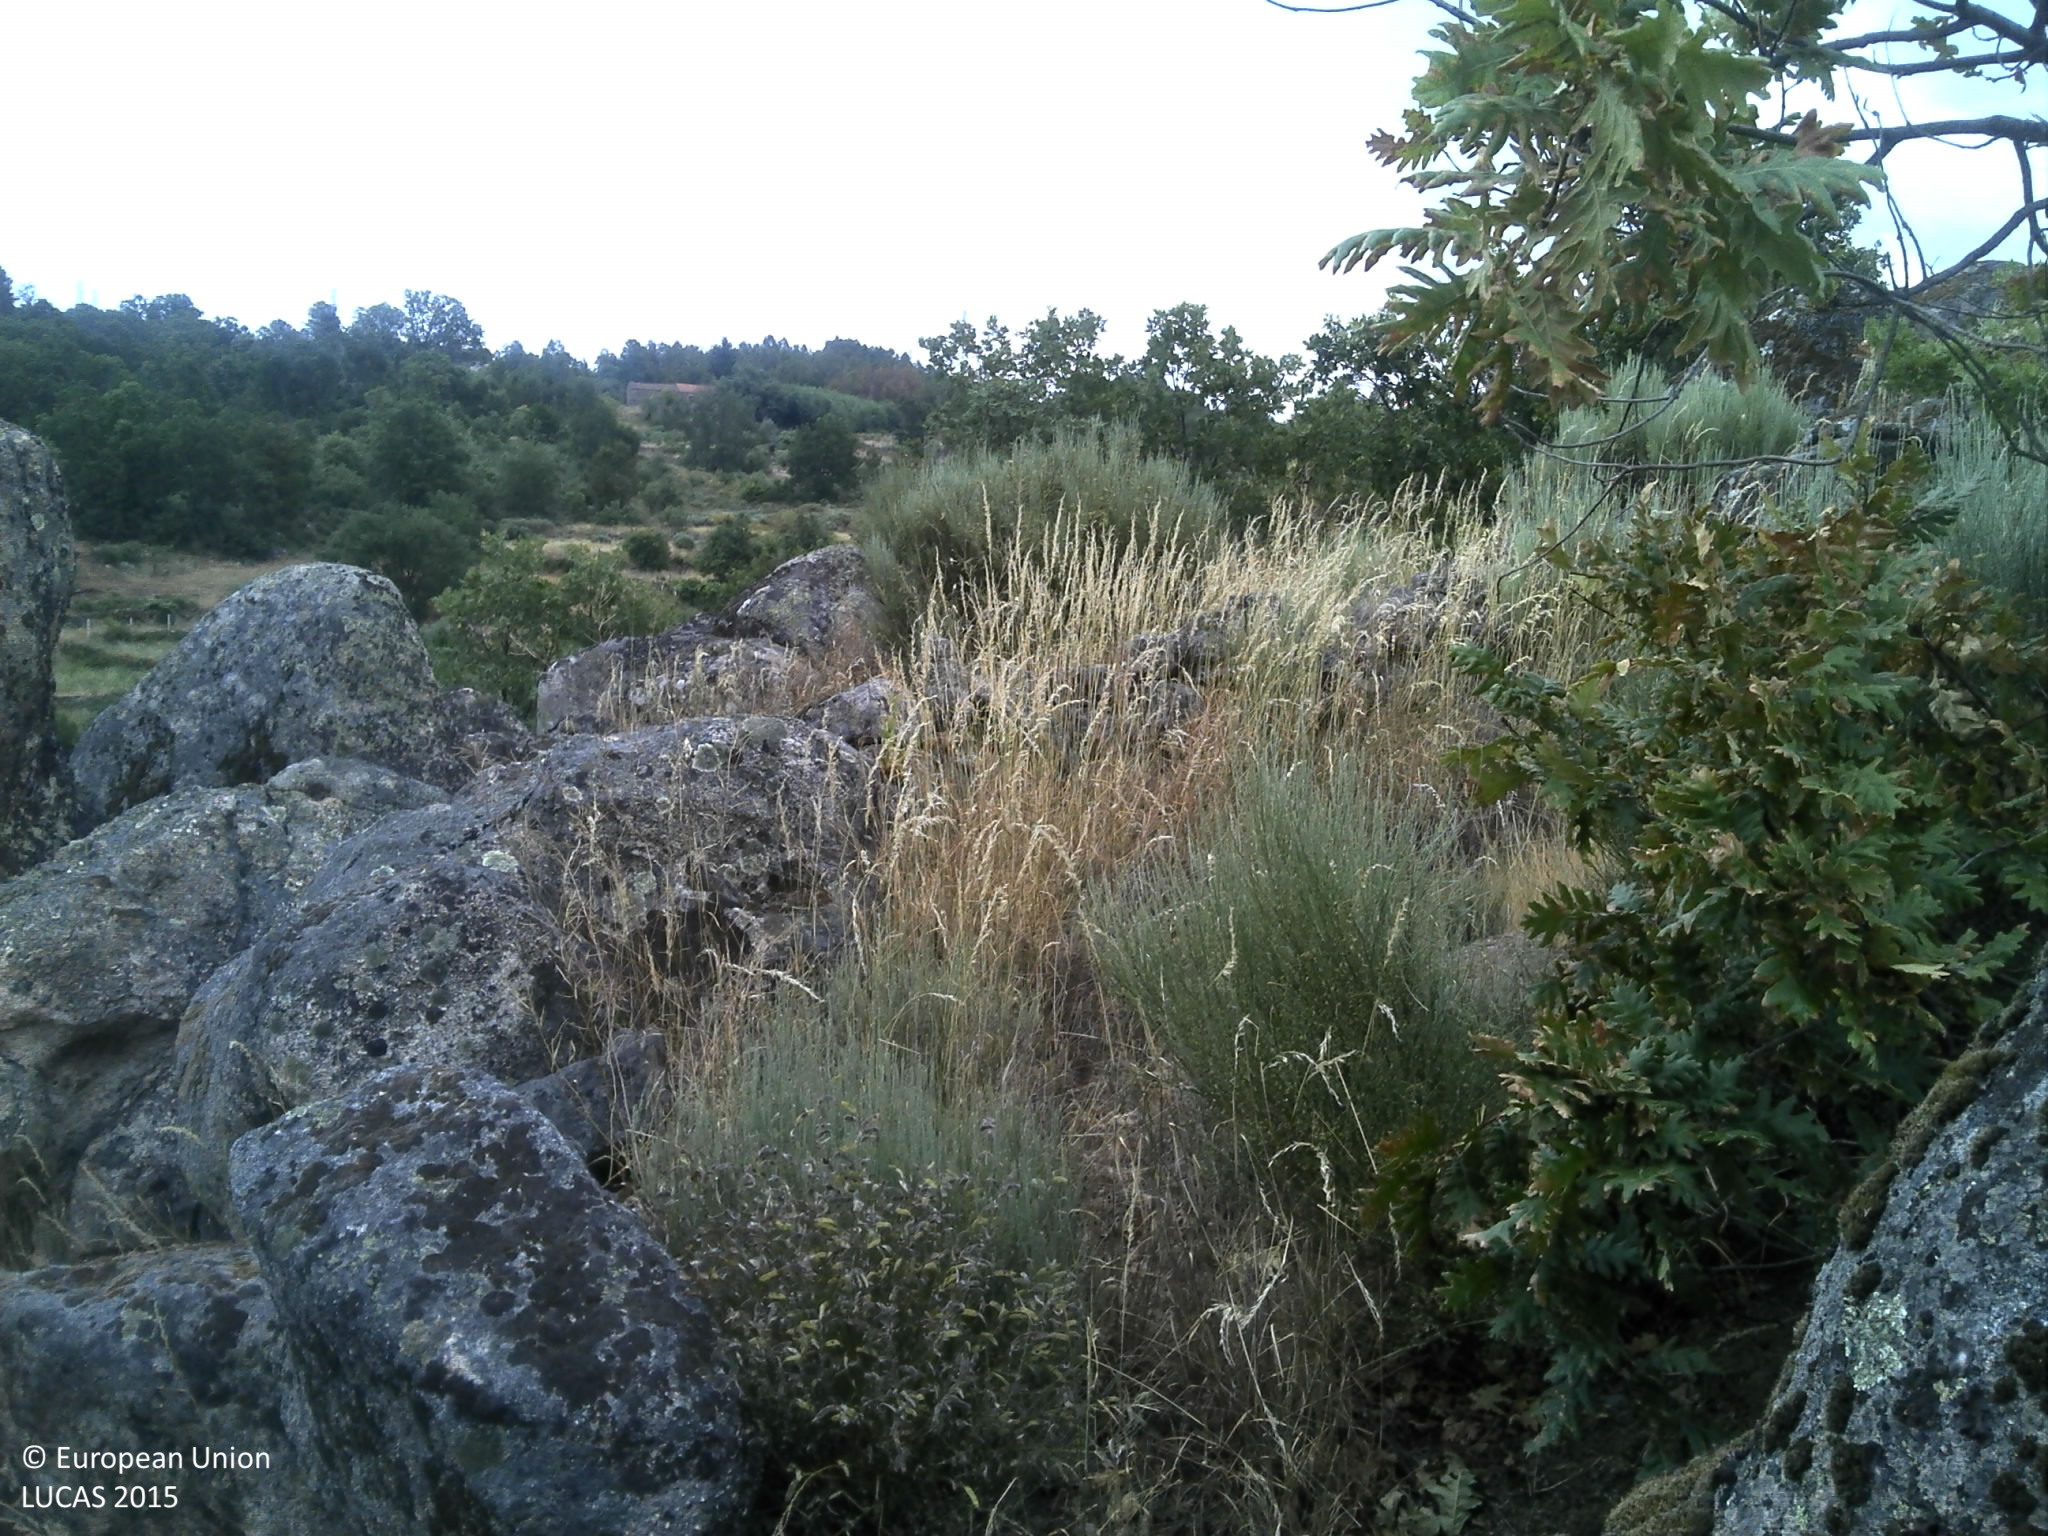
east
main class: Shrubland
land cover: Shrubland with sparse tree cover
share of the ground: 50 - 75 %
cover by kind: shrubs 60 %, herbaceous plants 15 %, consolidated bare surface 10 %, unconsolidated bare surface 10 %, broadleaved forest trees 5 %
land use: Abandoned areas
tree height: > 5 m
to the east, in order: Shrubland with sparse tree cover; Broadleaved woodland; Dry stone walls; Shrubland with sparse tree cover
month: June
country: PT
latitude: 40.3216
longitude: -7.2005
